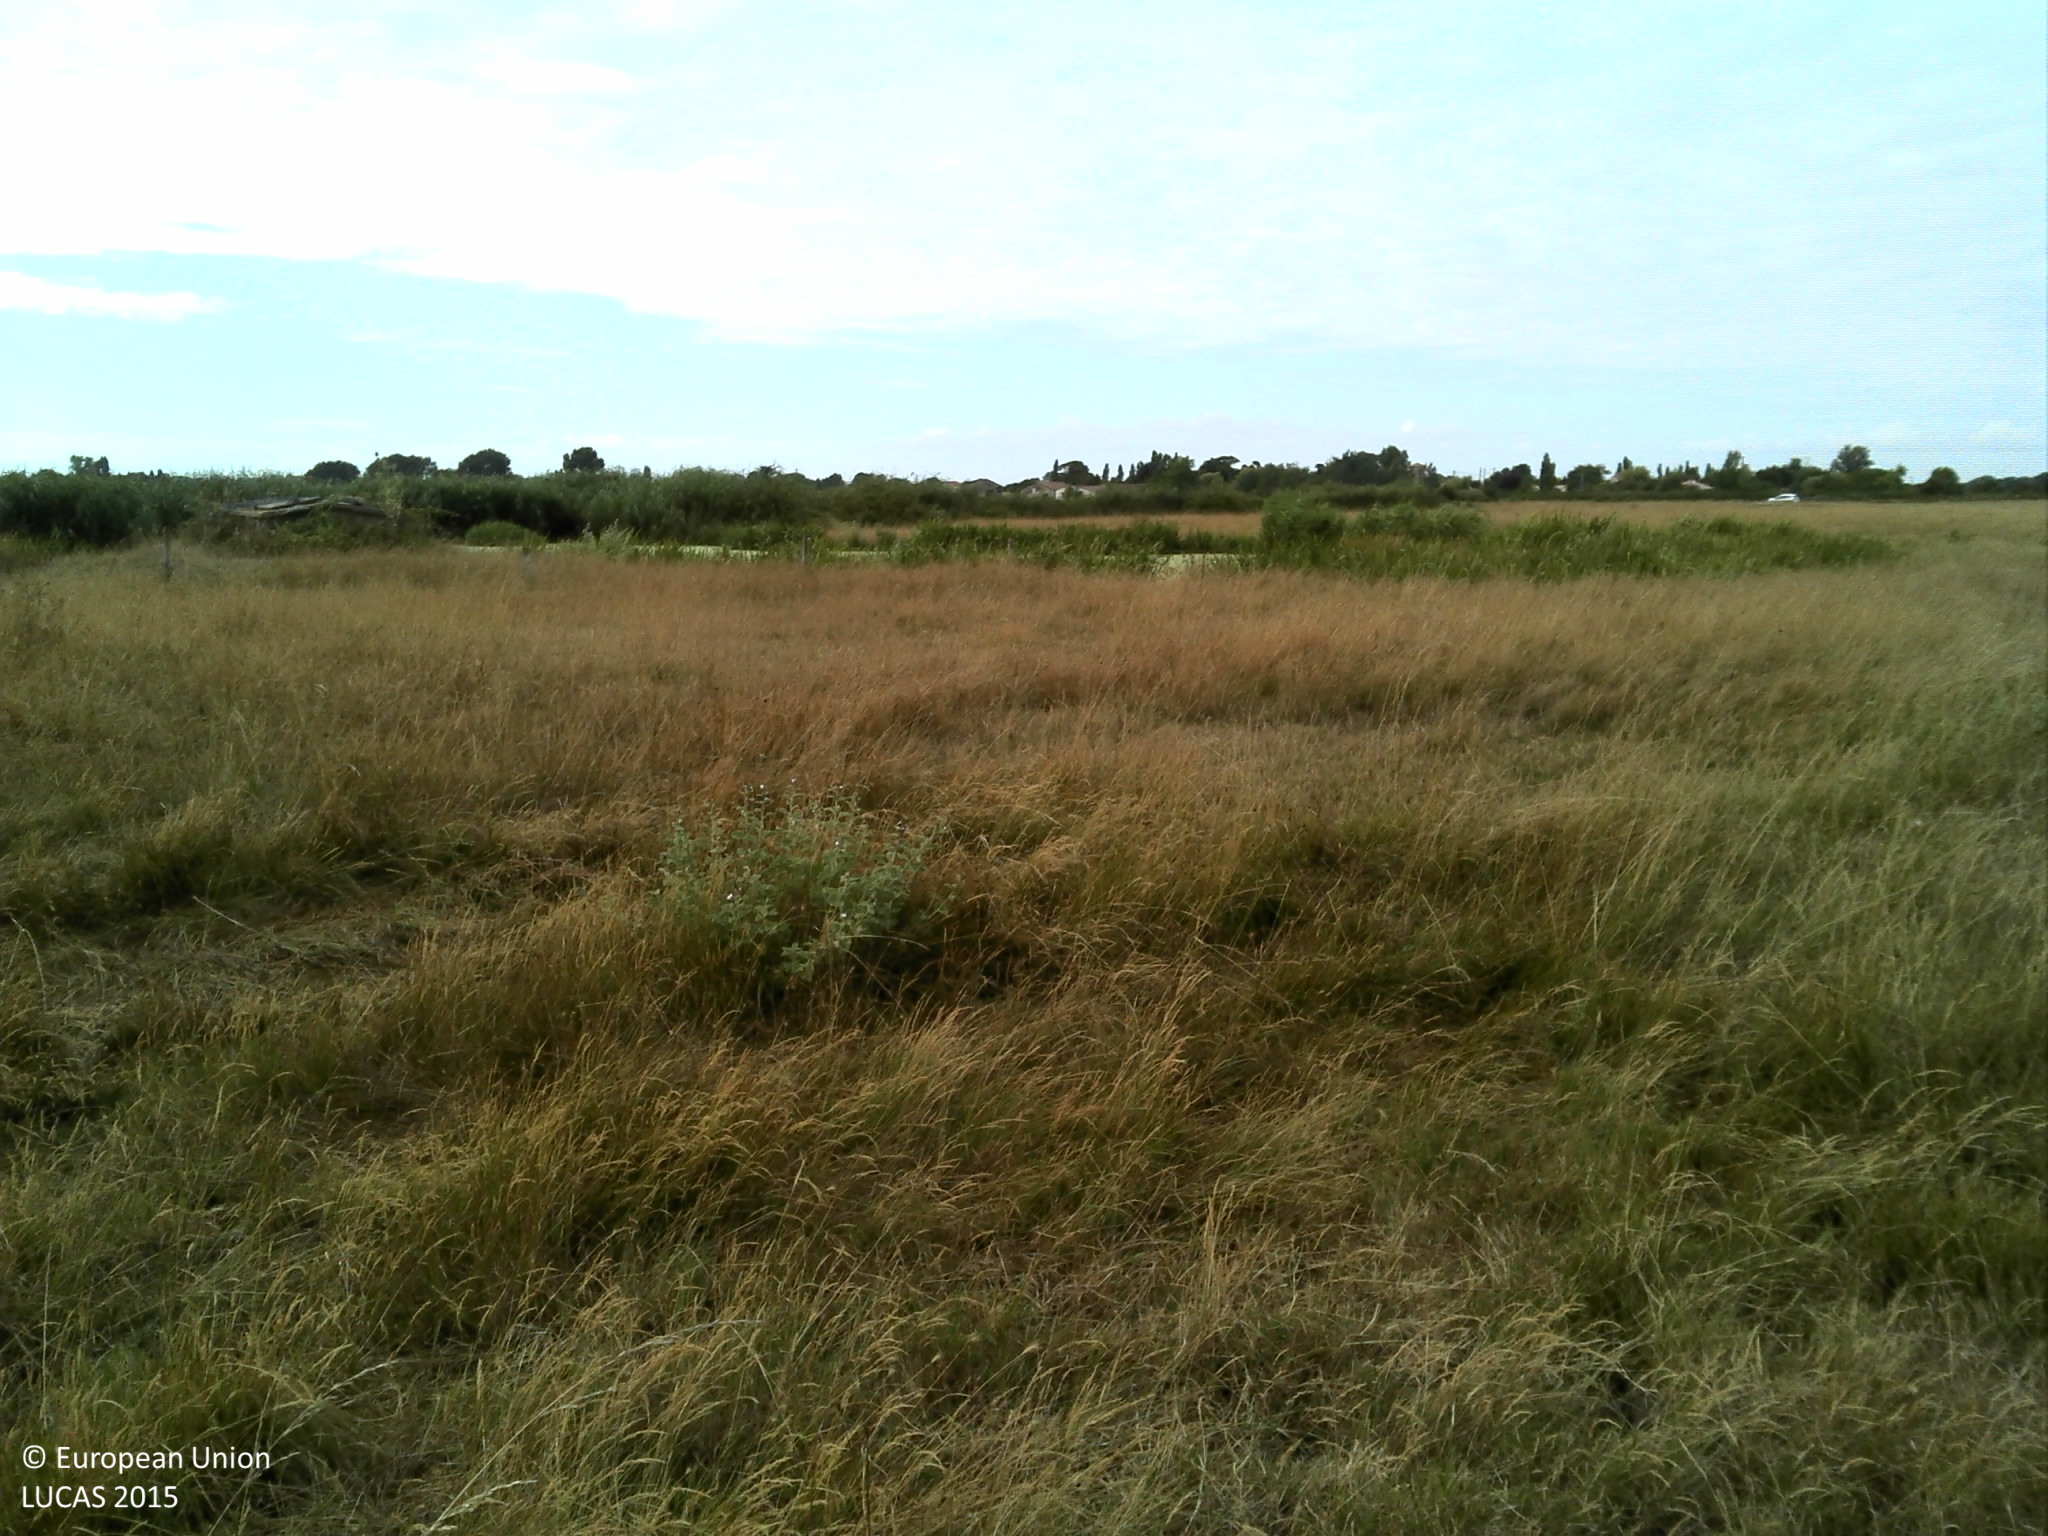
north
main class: Grassland
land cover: Grassland without tree/shrub cover
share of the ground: > 75 %
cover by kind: herbaceous plants 100 %
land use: Agriculture (excluding fallow land and kitchen gardens)
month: July
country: FR
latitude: 45.4992
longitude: -1.0975
